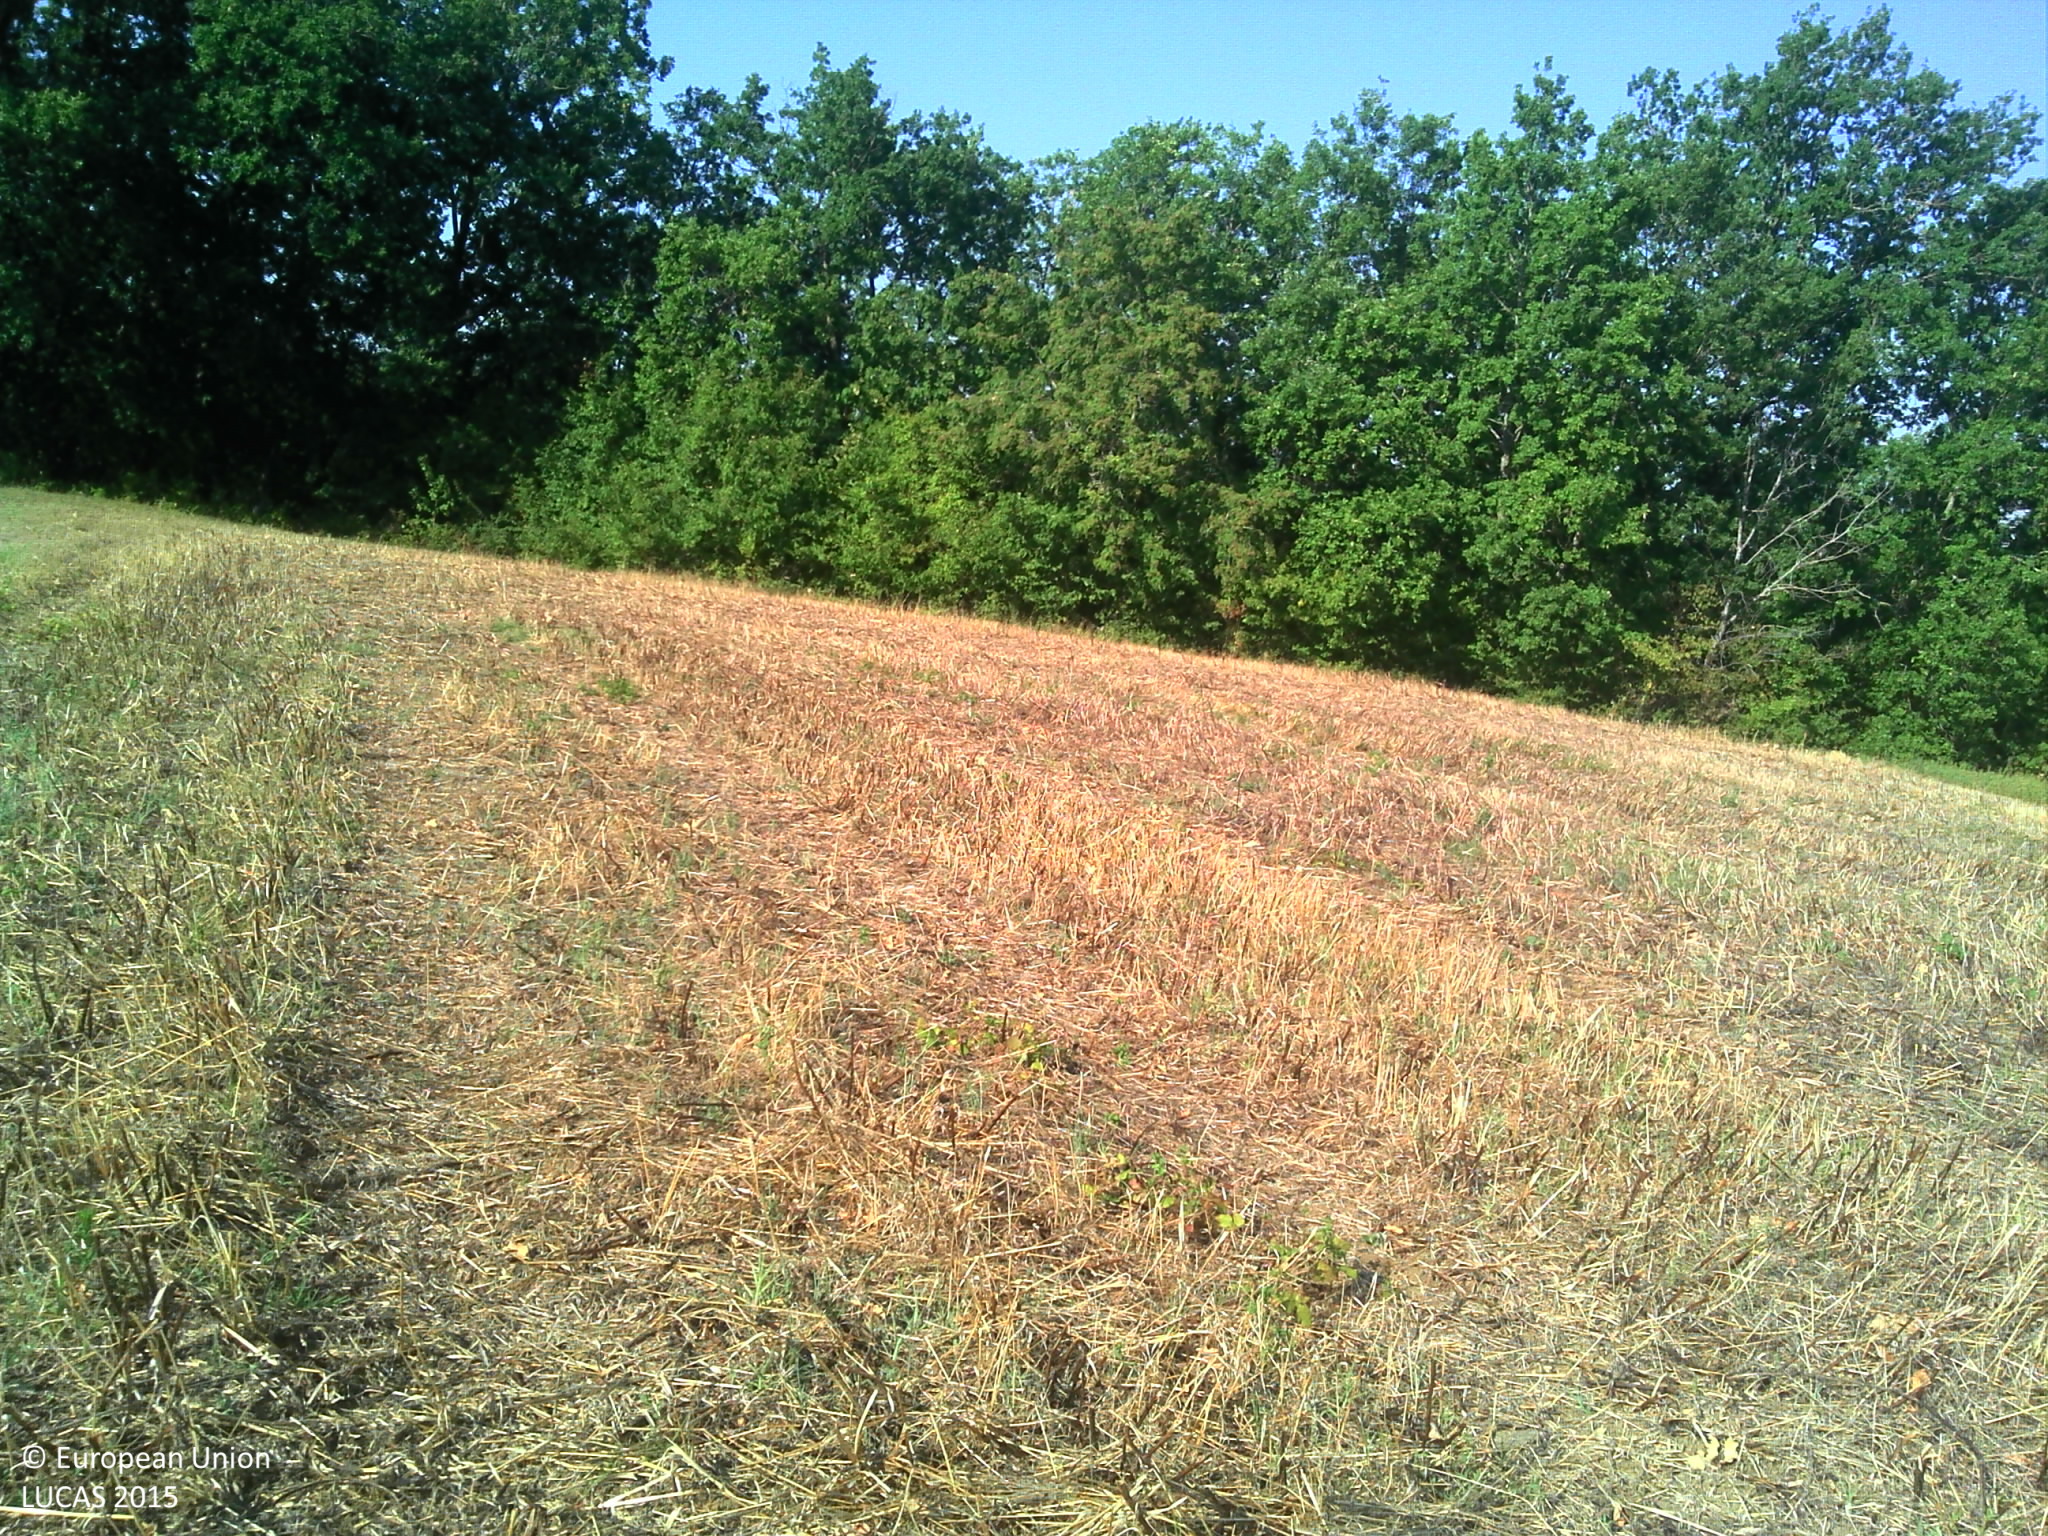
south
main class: Cropland
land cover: Dry pulses
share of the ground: 50 - 75 %
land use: Agriculture (excluding fallow land and kitchen gardens)
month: August
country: FR
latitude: 44.2318
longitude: 1.2218
